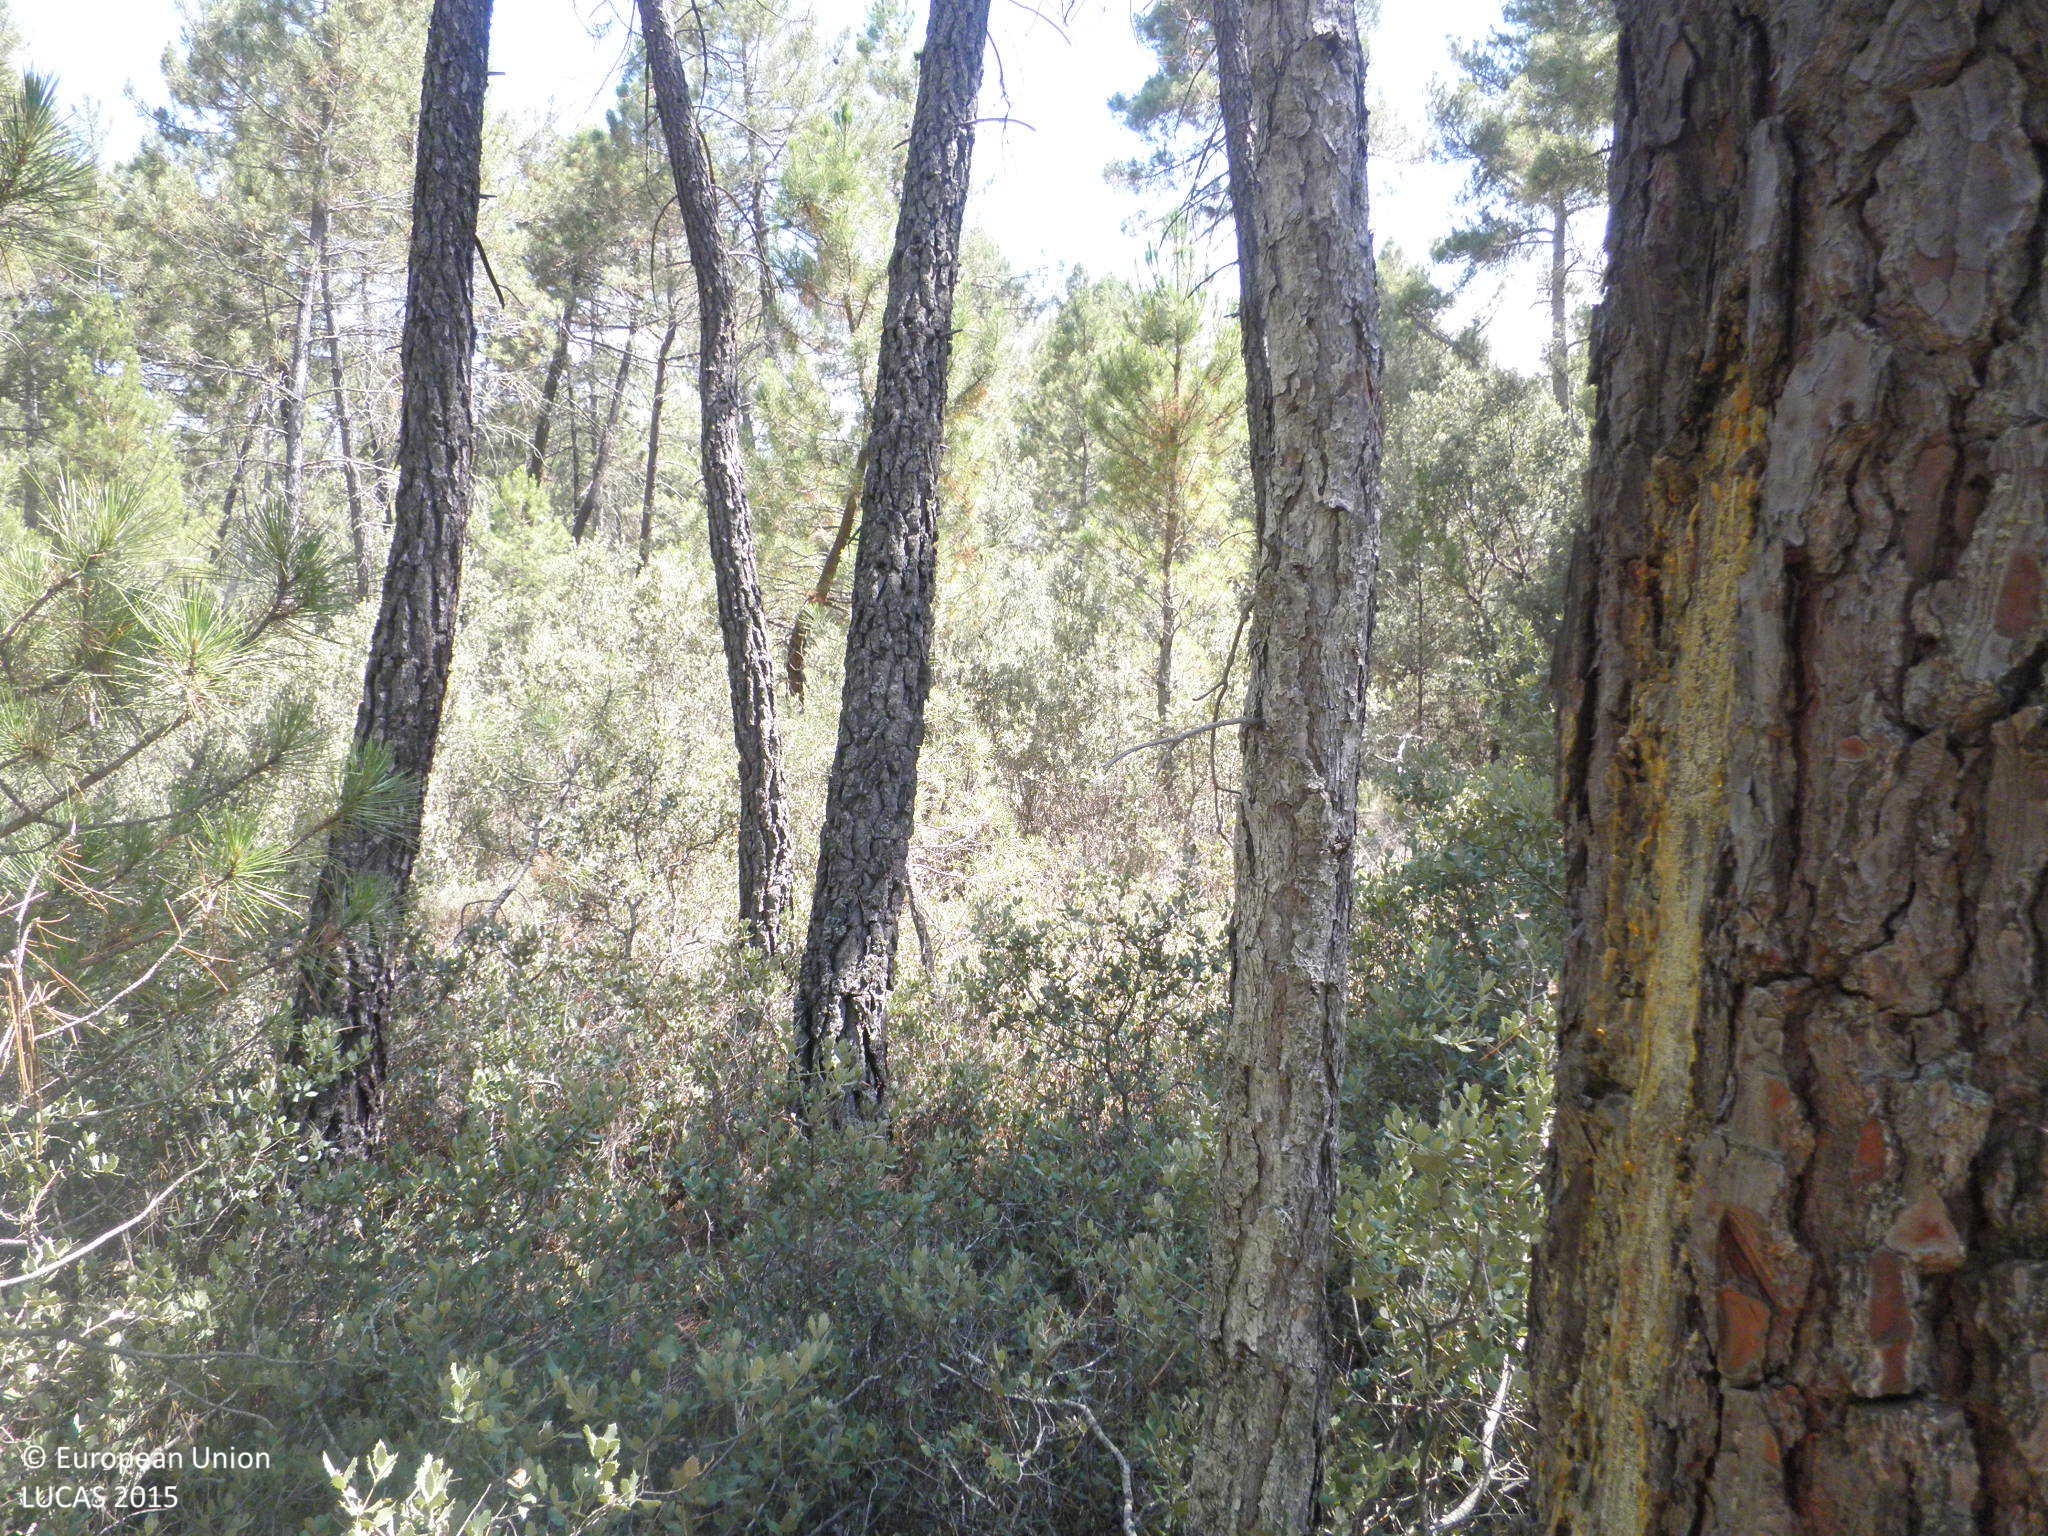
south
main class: Woodland
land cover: Pine dominated mixed woodland
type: coniferous forest of the mediterranean region
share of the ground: 50 - 75 %
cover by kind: coniferous forest trees 35 %, broadleaved forest trees 25 %, unconsolidated bare surface 20 %, herbaceous plants 15 %, shrubs 5 %
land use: Forestry
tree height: > 5 m
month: July
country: ES
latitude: 39.6754
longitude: -1.8418
